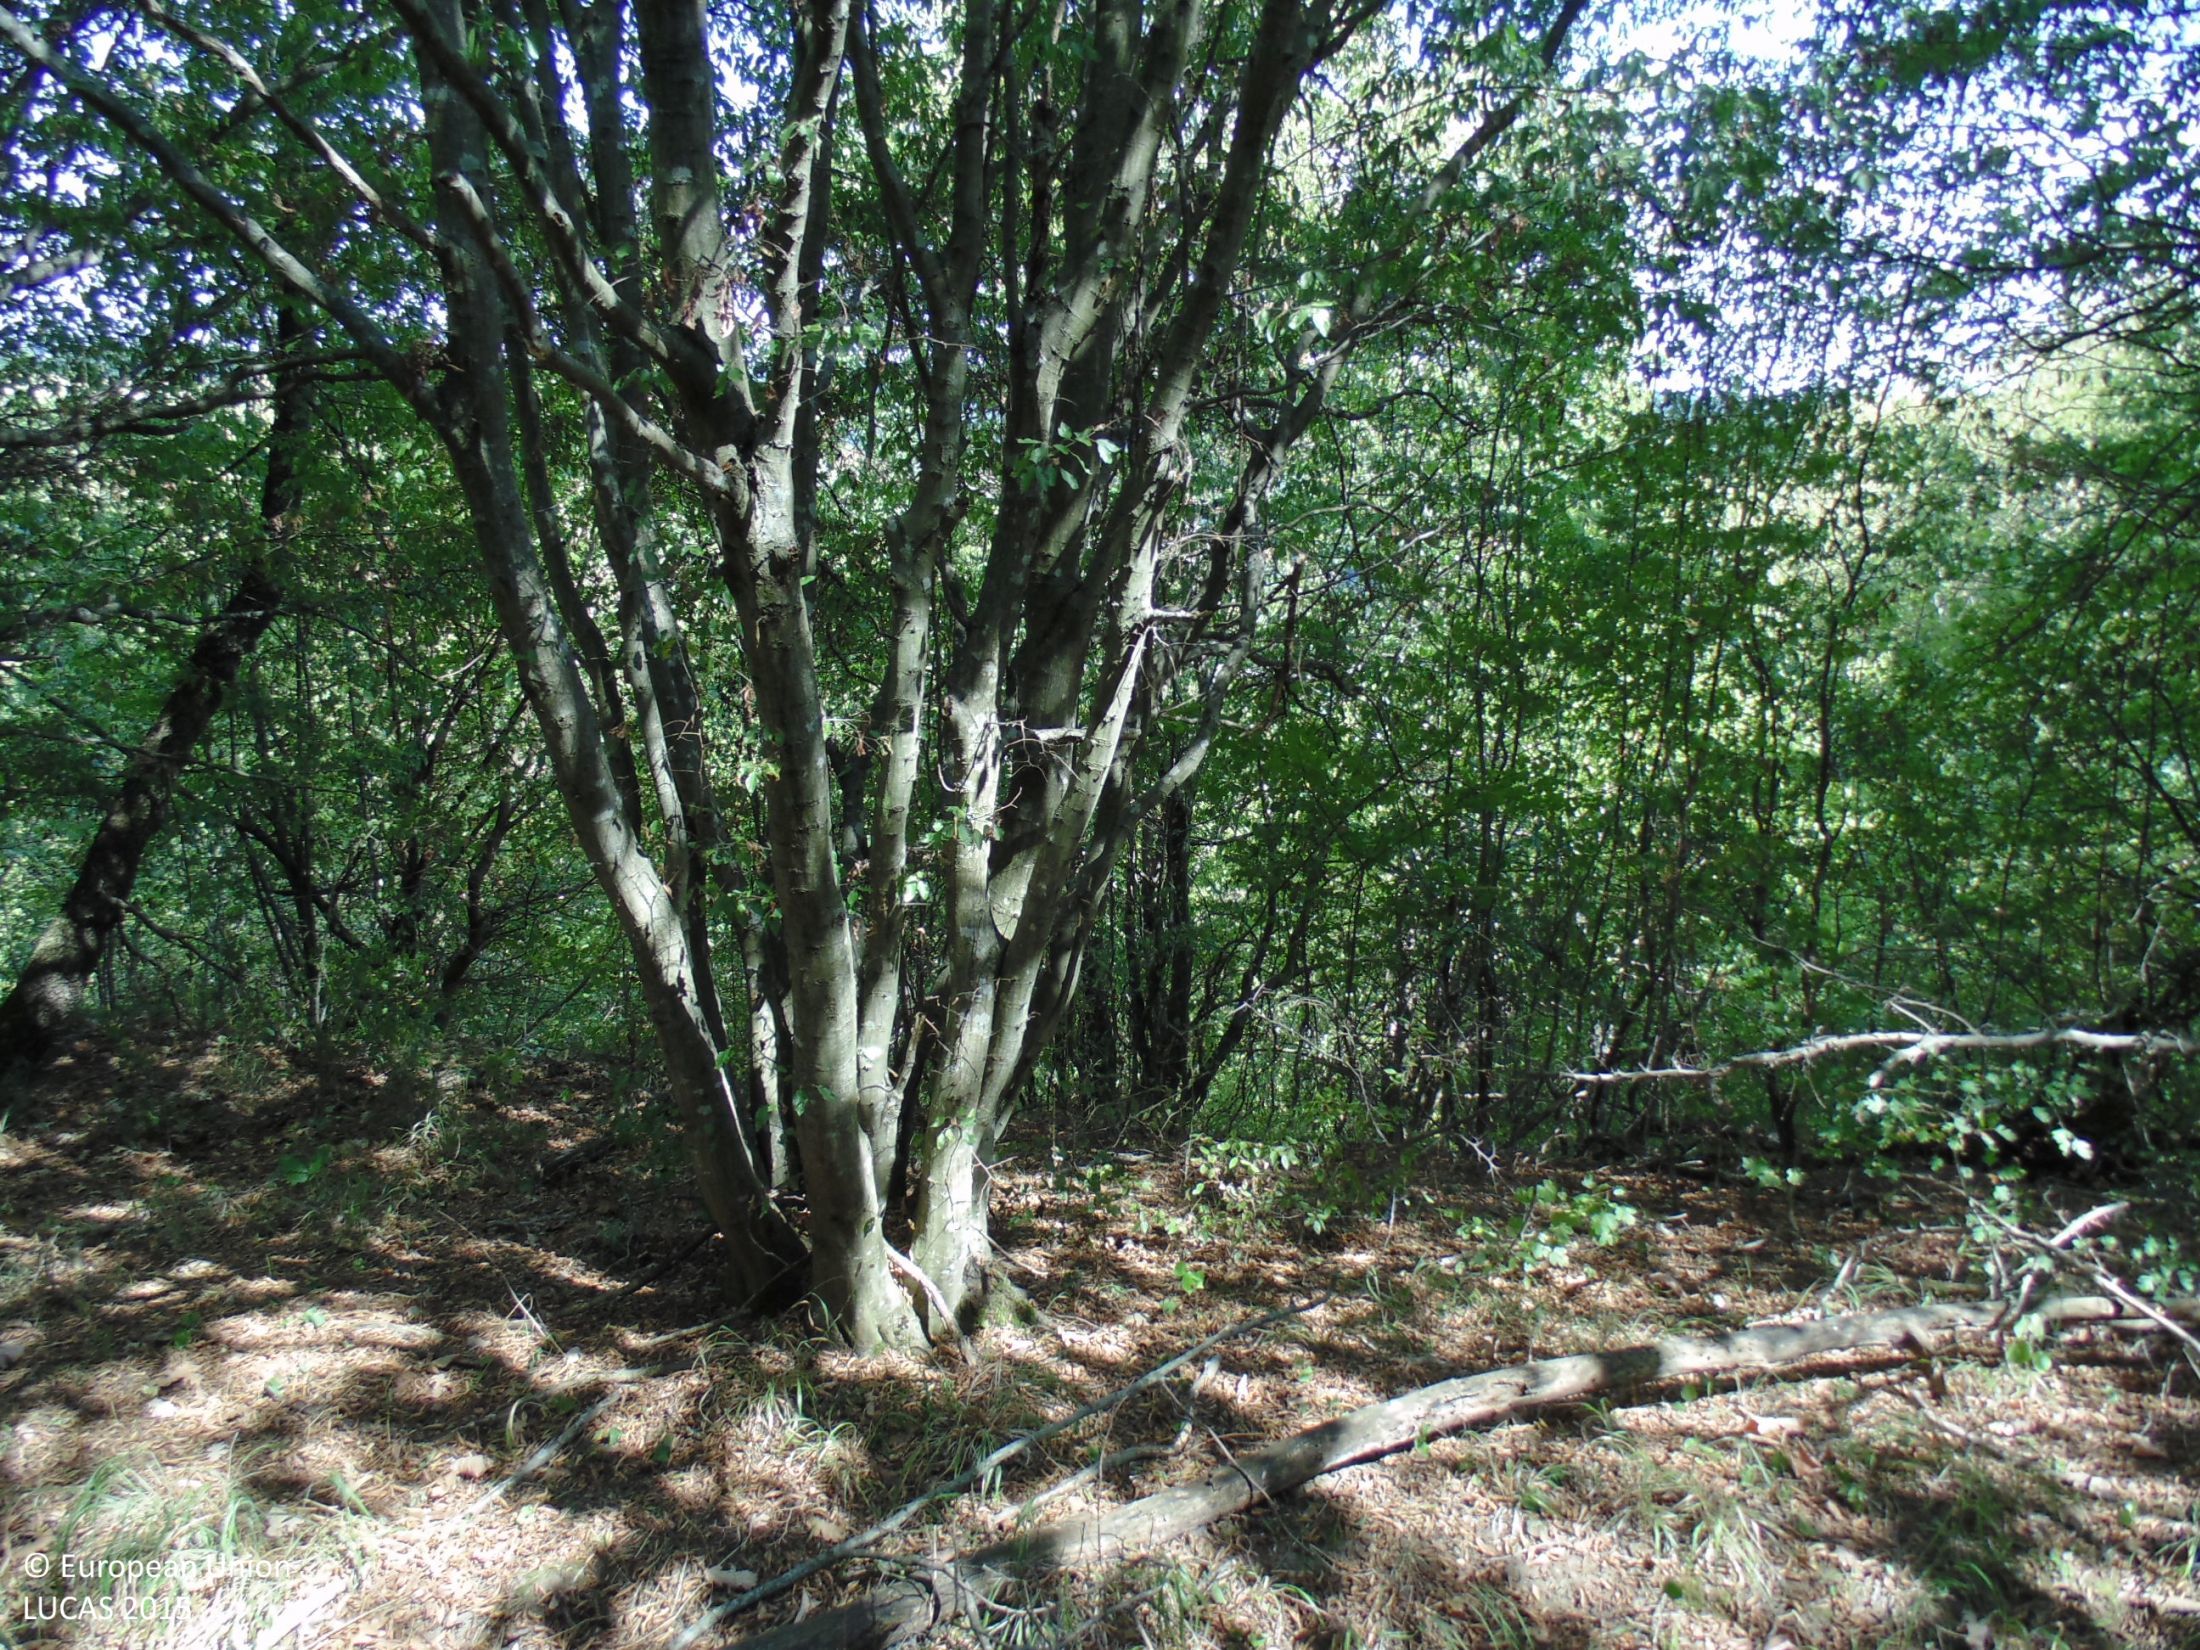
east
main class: Woodland
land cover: Broadleaved woodland
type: mesophytic deciduous forest
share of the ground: > 75 %
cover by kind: broadleaved forest trees 85 %, shrubs 10 %, unconsolidated bare surface 5 %
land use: Forestry
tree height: > 5 m
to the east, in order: Broadleaved woodland; Spontaneously vegetated surfaces; Inland marshes
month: August
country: BG
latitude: 43.8078
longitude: 27.6031
